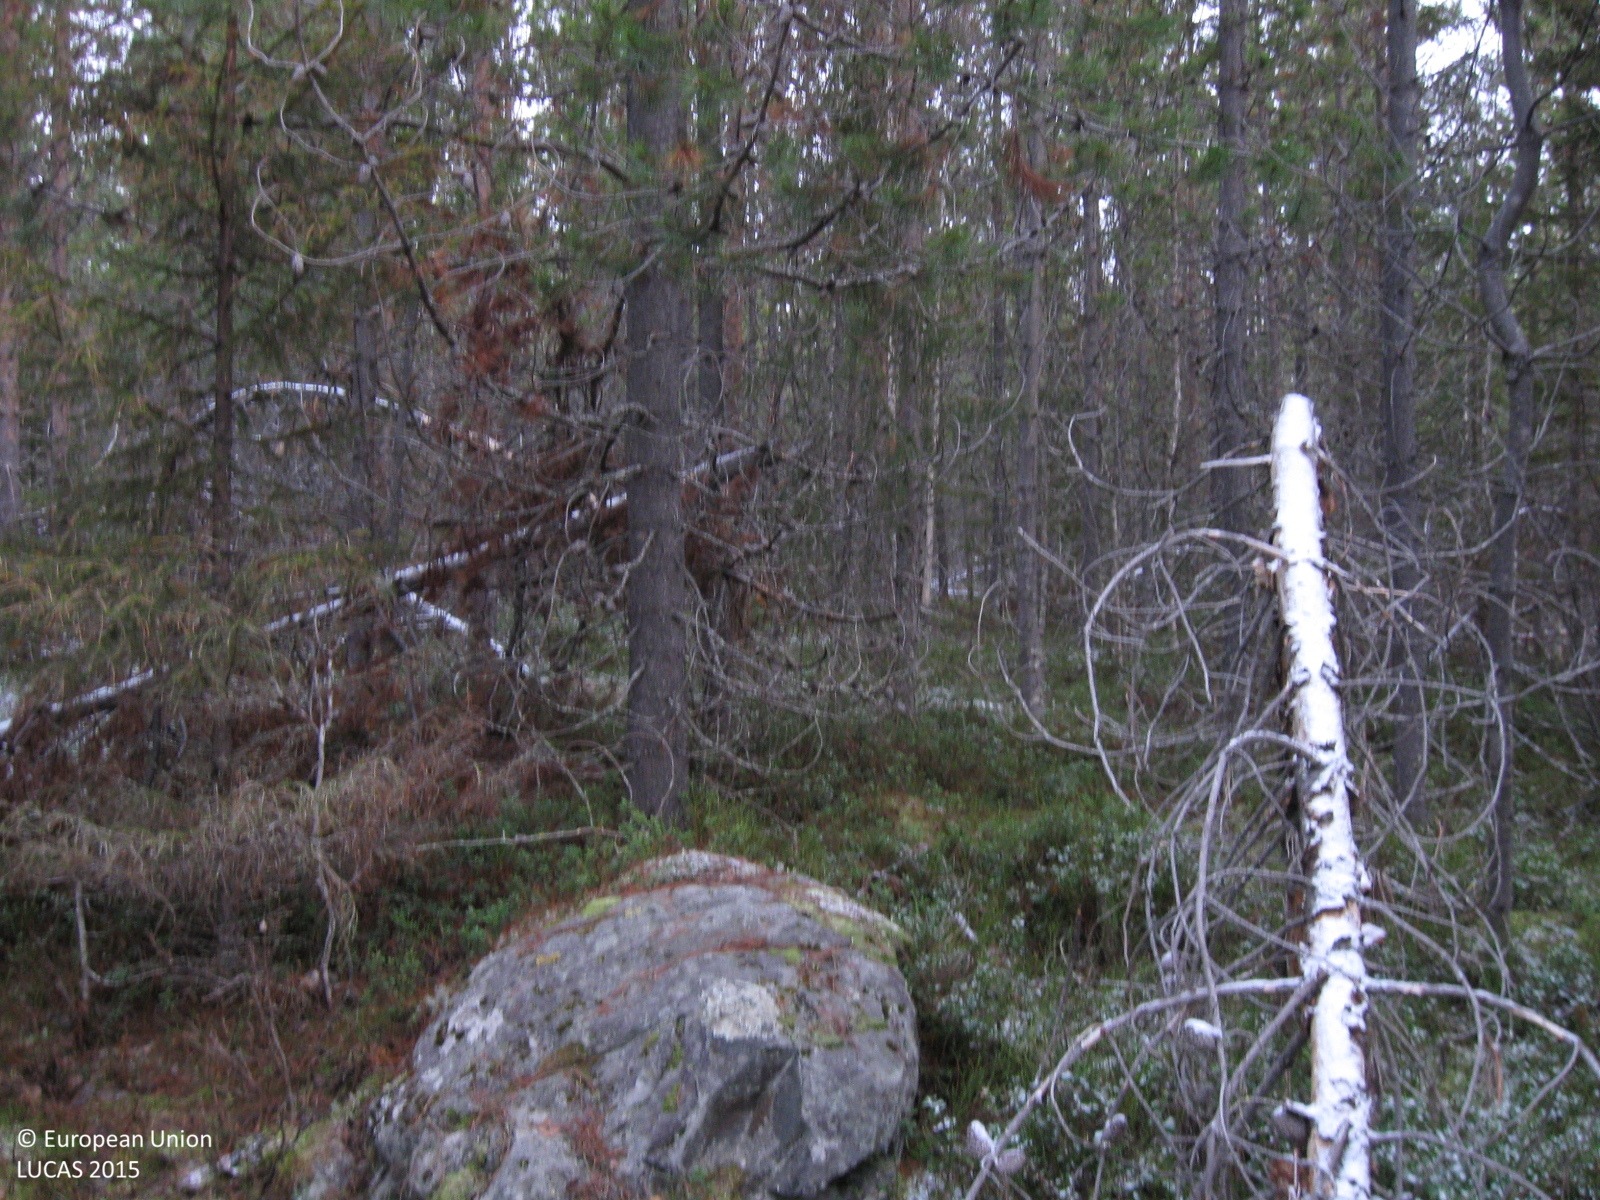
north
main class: Woodland
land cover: Pine dominated coniferous woodland
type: exotic forest
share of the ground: > 75 %
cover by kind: coniferous forest trees 80 %, broadleaved forest trees 5 %, shrubs 5 %, lichens and mosses 5 %, unconsolidated bare surface 5 %
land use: Forestry
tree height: > 5 m
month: October
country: SE
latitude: 66.2005
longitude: 21.6710
